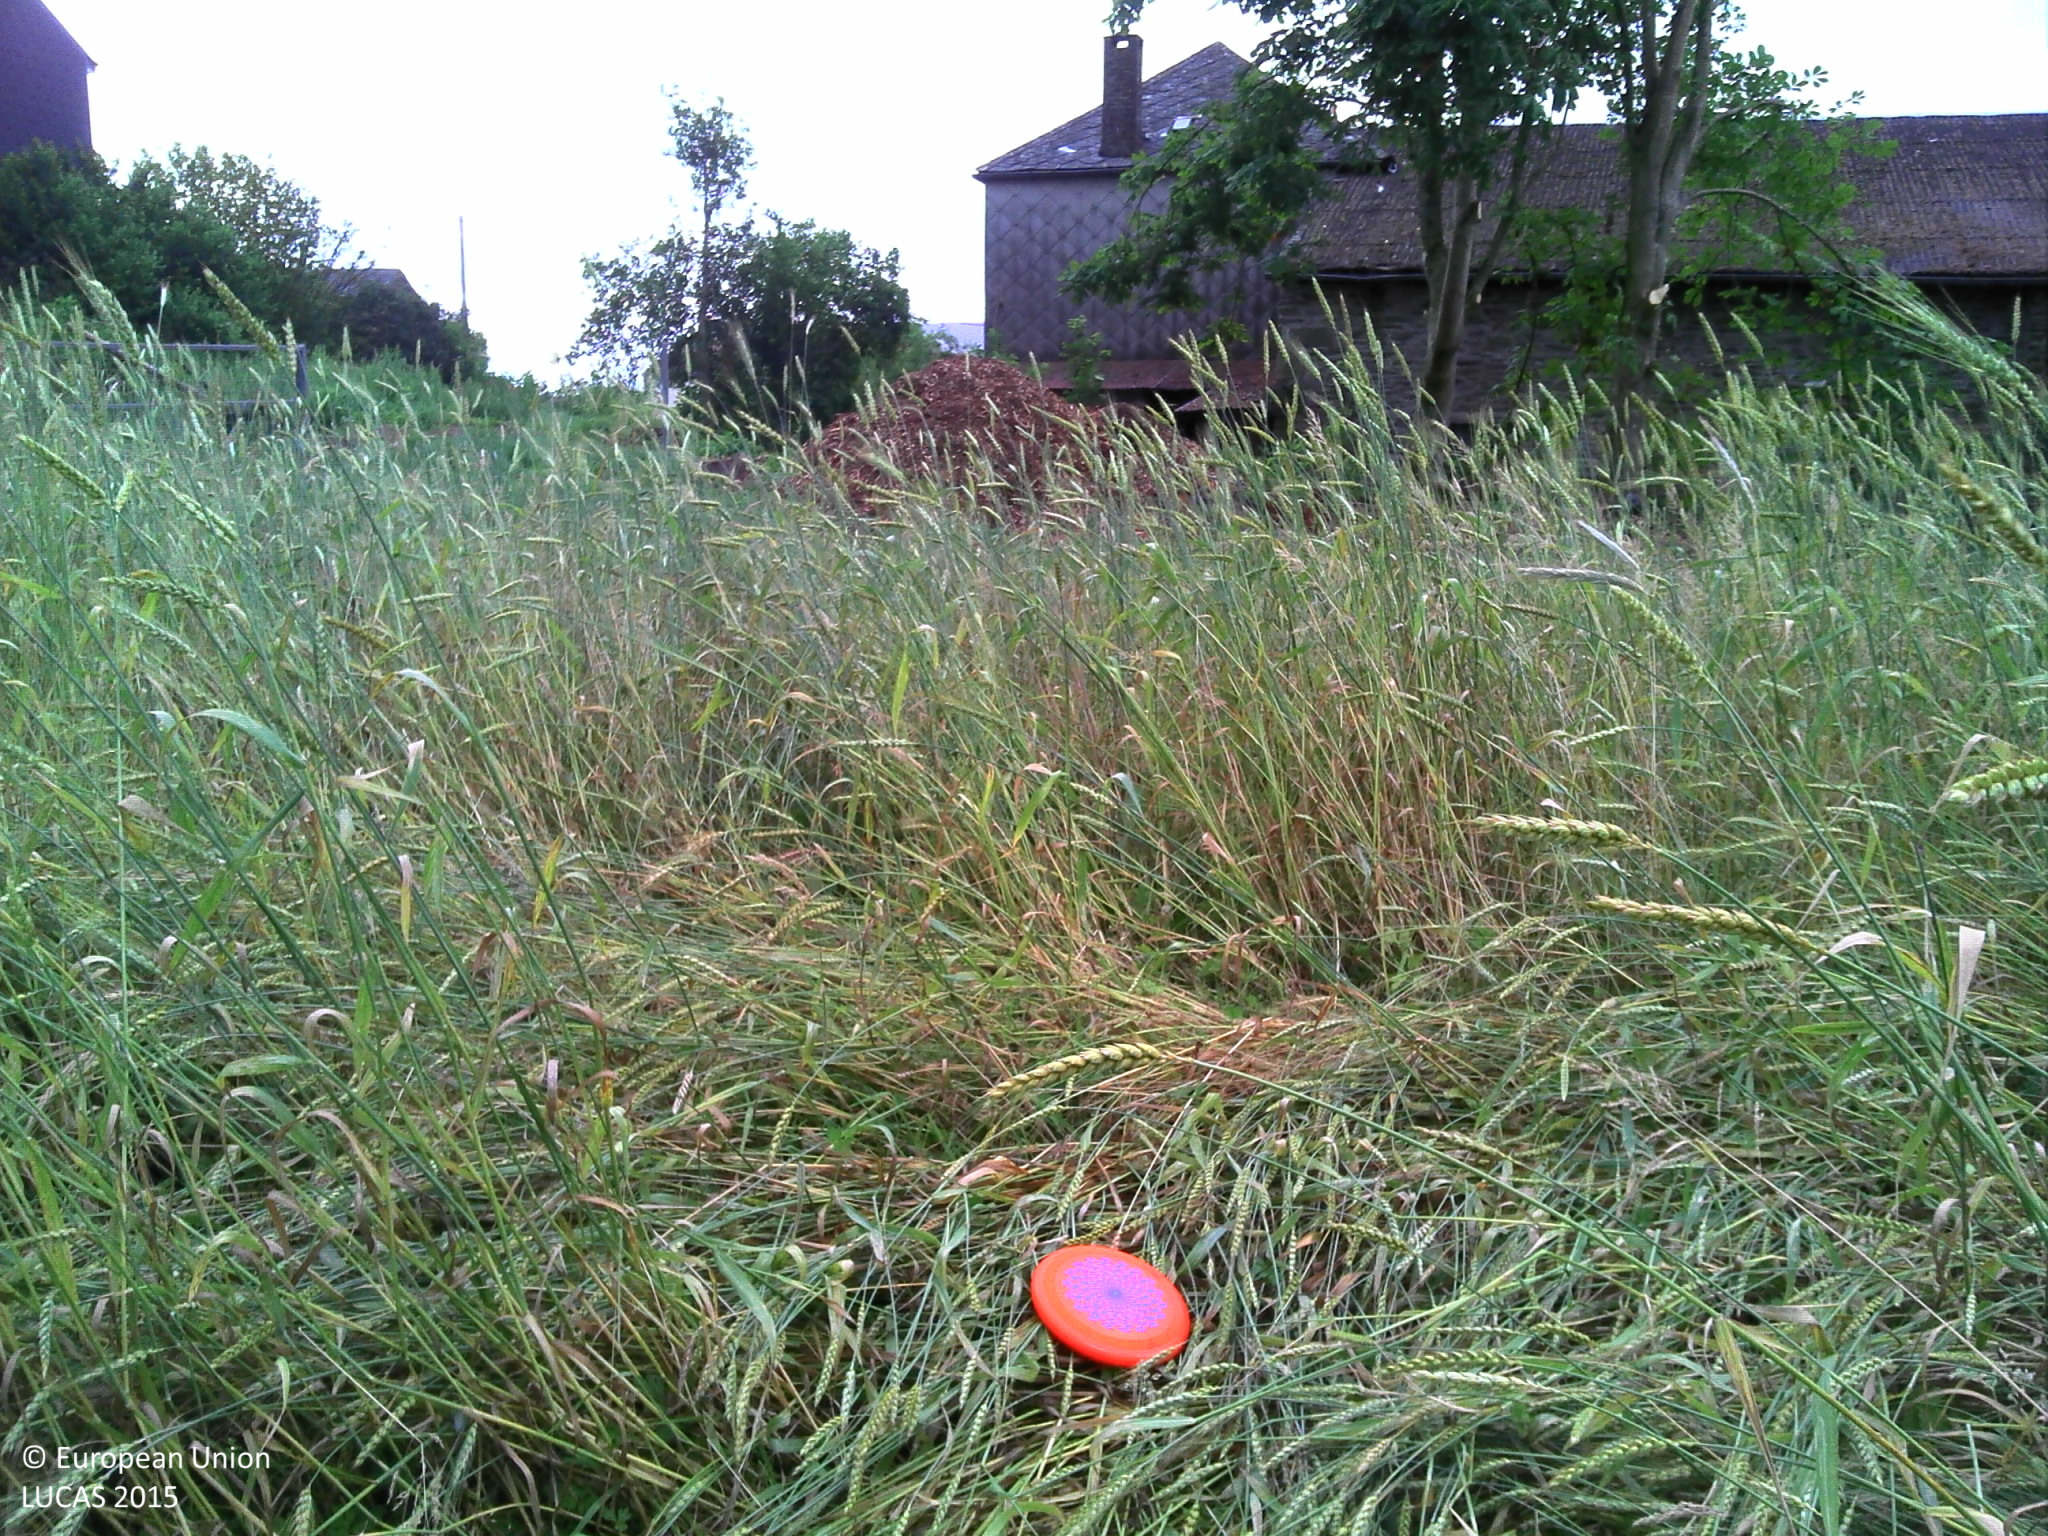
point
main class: Cropland
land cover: Mixed cereals for fodder
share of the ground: > 75 %
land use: Agriculture (excluding fallow land and kitchen gardens)
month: July
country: BE
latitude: 50.1814
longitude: 5.8677
